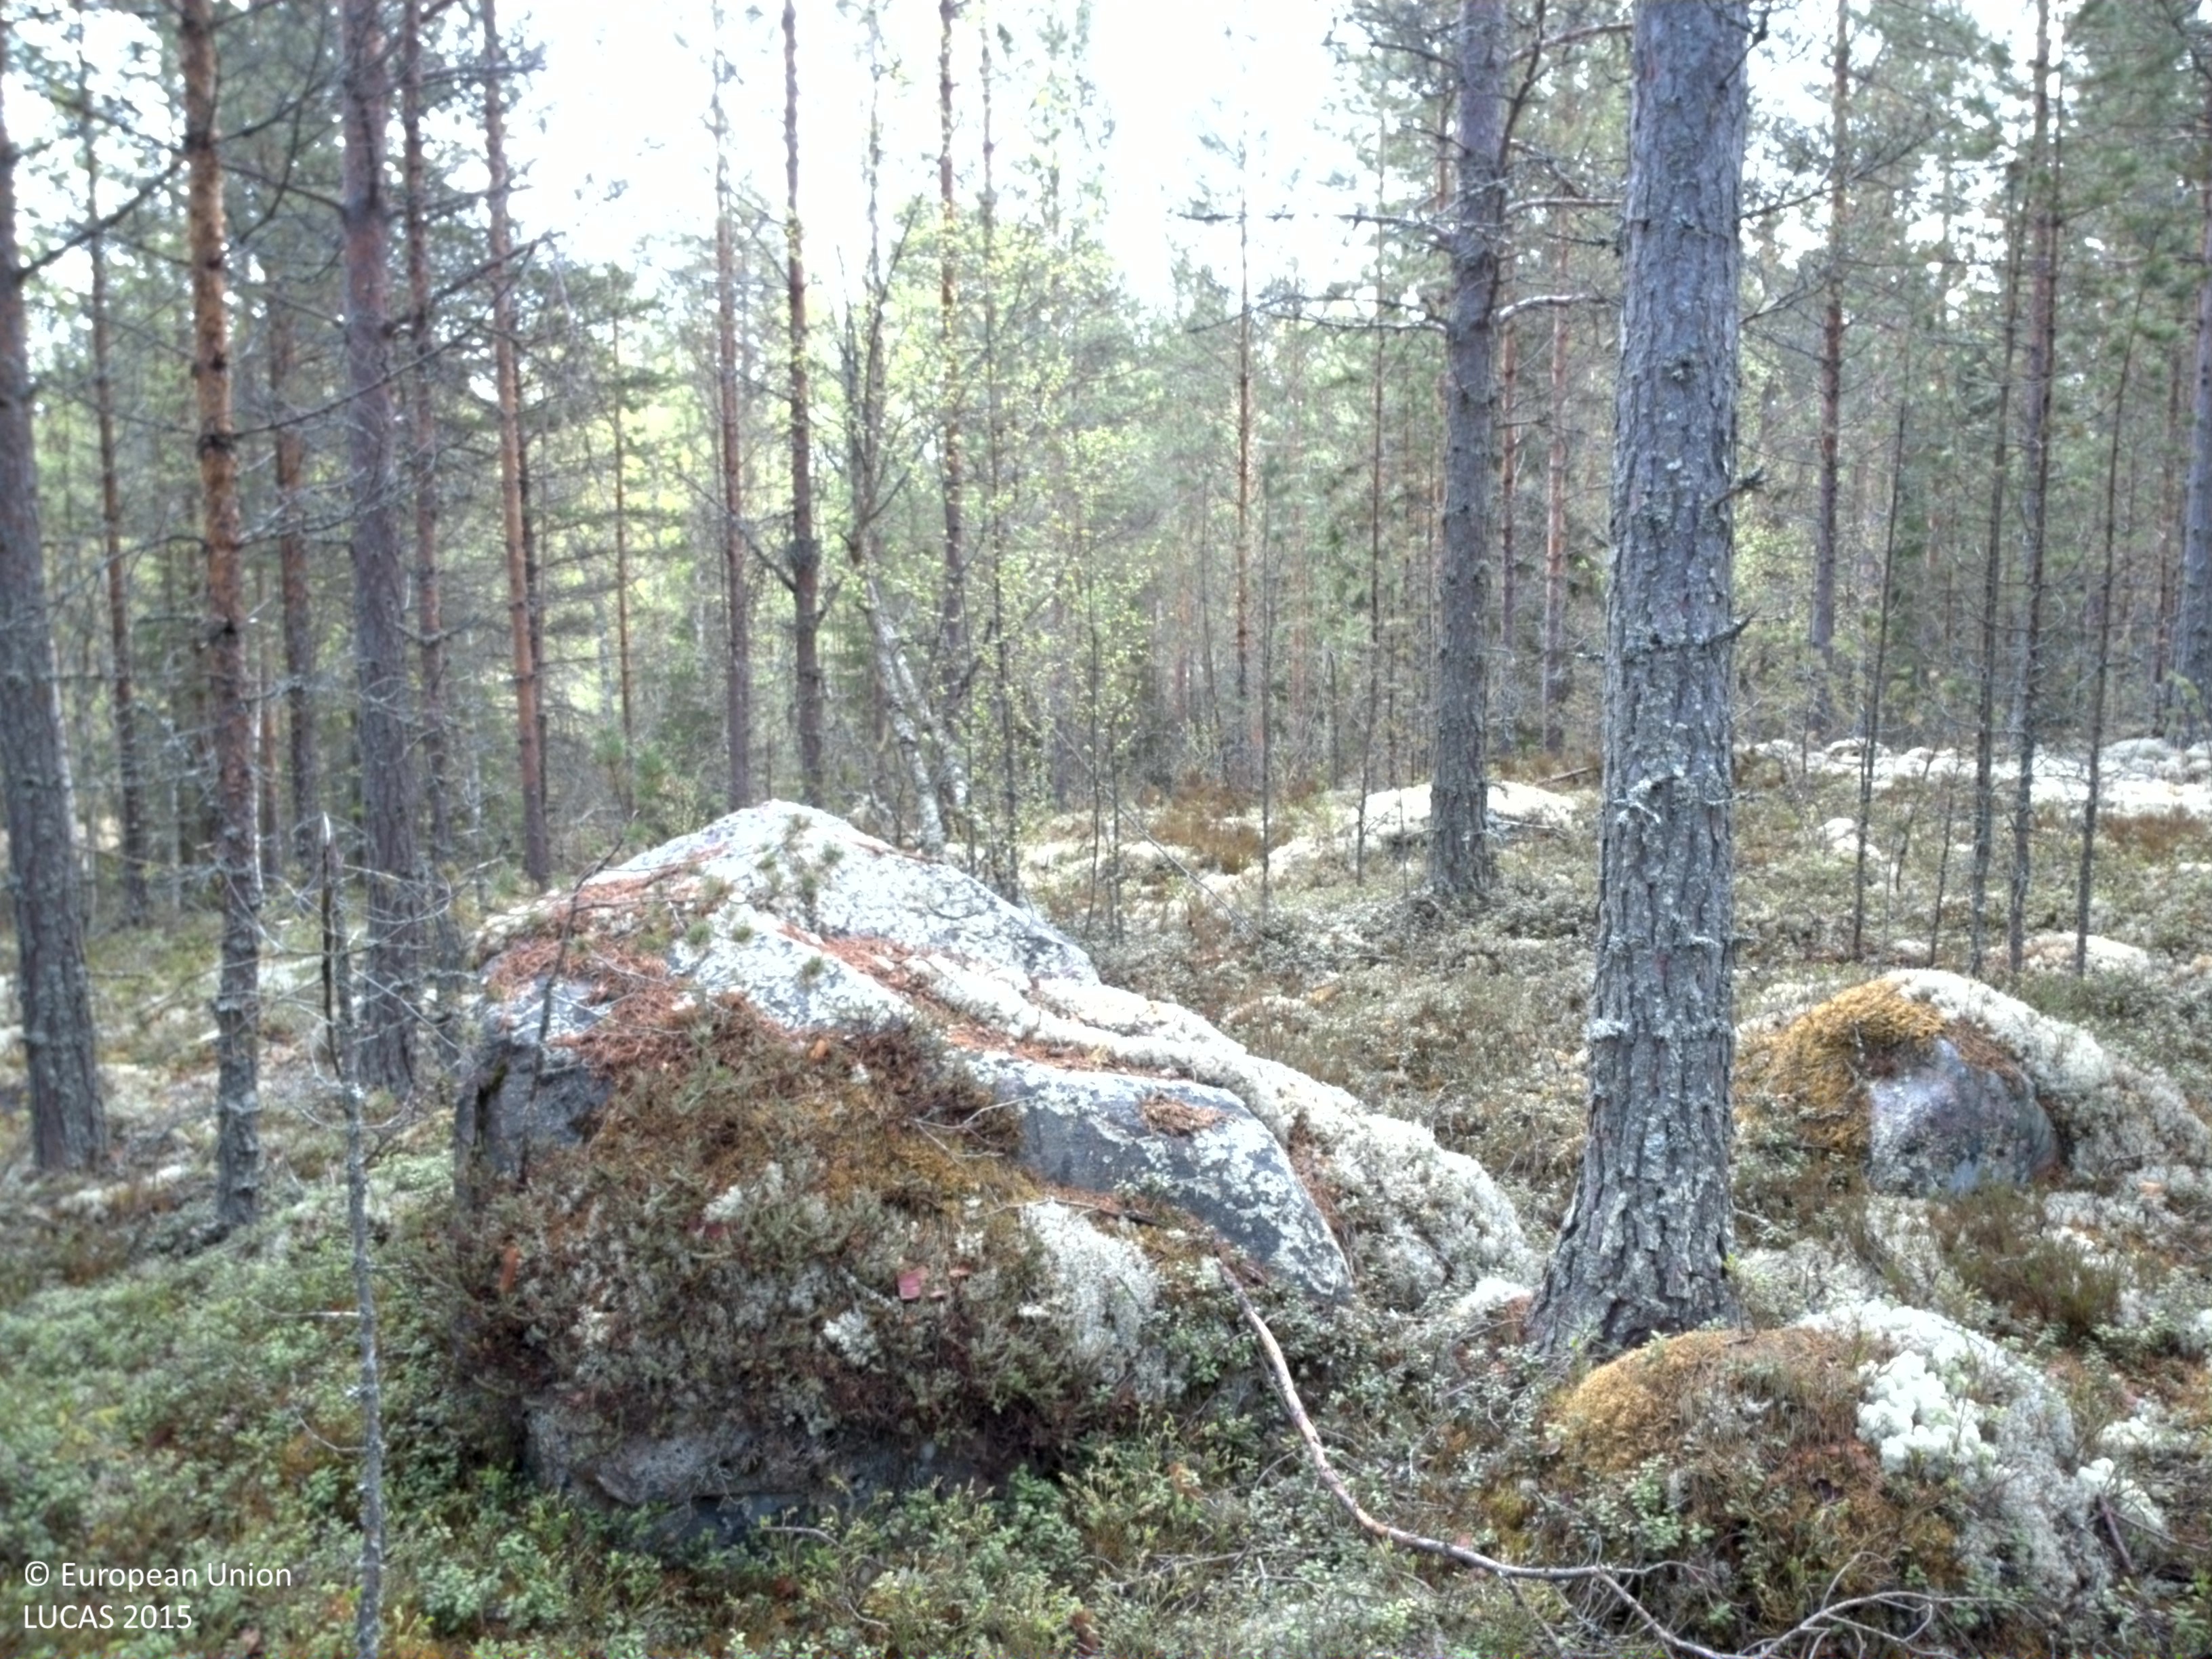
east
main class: Woodland
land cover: Pine dominated coniferous woodland
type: boreal forest
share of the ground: 50 - 75 %
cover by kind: coniferous forest trees 65 %, herbaceous plants 30 %, lichens and mosses 5 %
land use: Forestry
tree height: > 5 m
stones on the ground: < 10 %
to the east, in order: Pine dominated coniferous woodland; Pine dominated mixed woodland; Pine dominated coniferous woodland; Pine dominated mixed woodland; Peatbogs; Pine dominated mixed woodland; Rivers and streams; Pine dominated mixed woodland
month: May
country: SE
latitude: 61.2132
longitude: 15.4395
